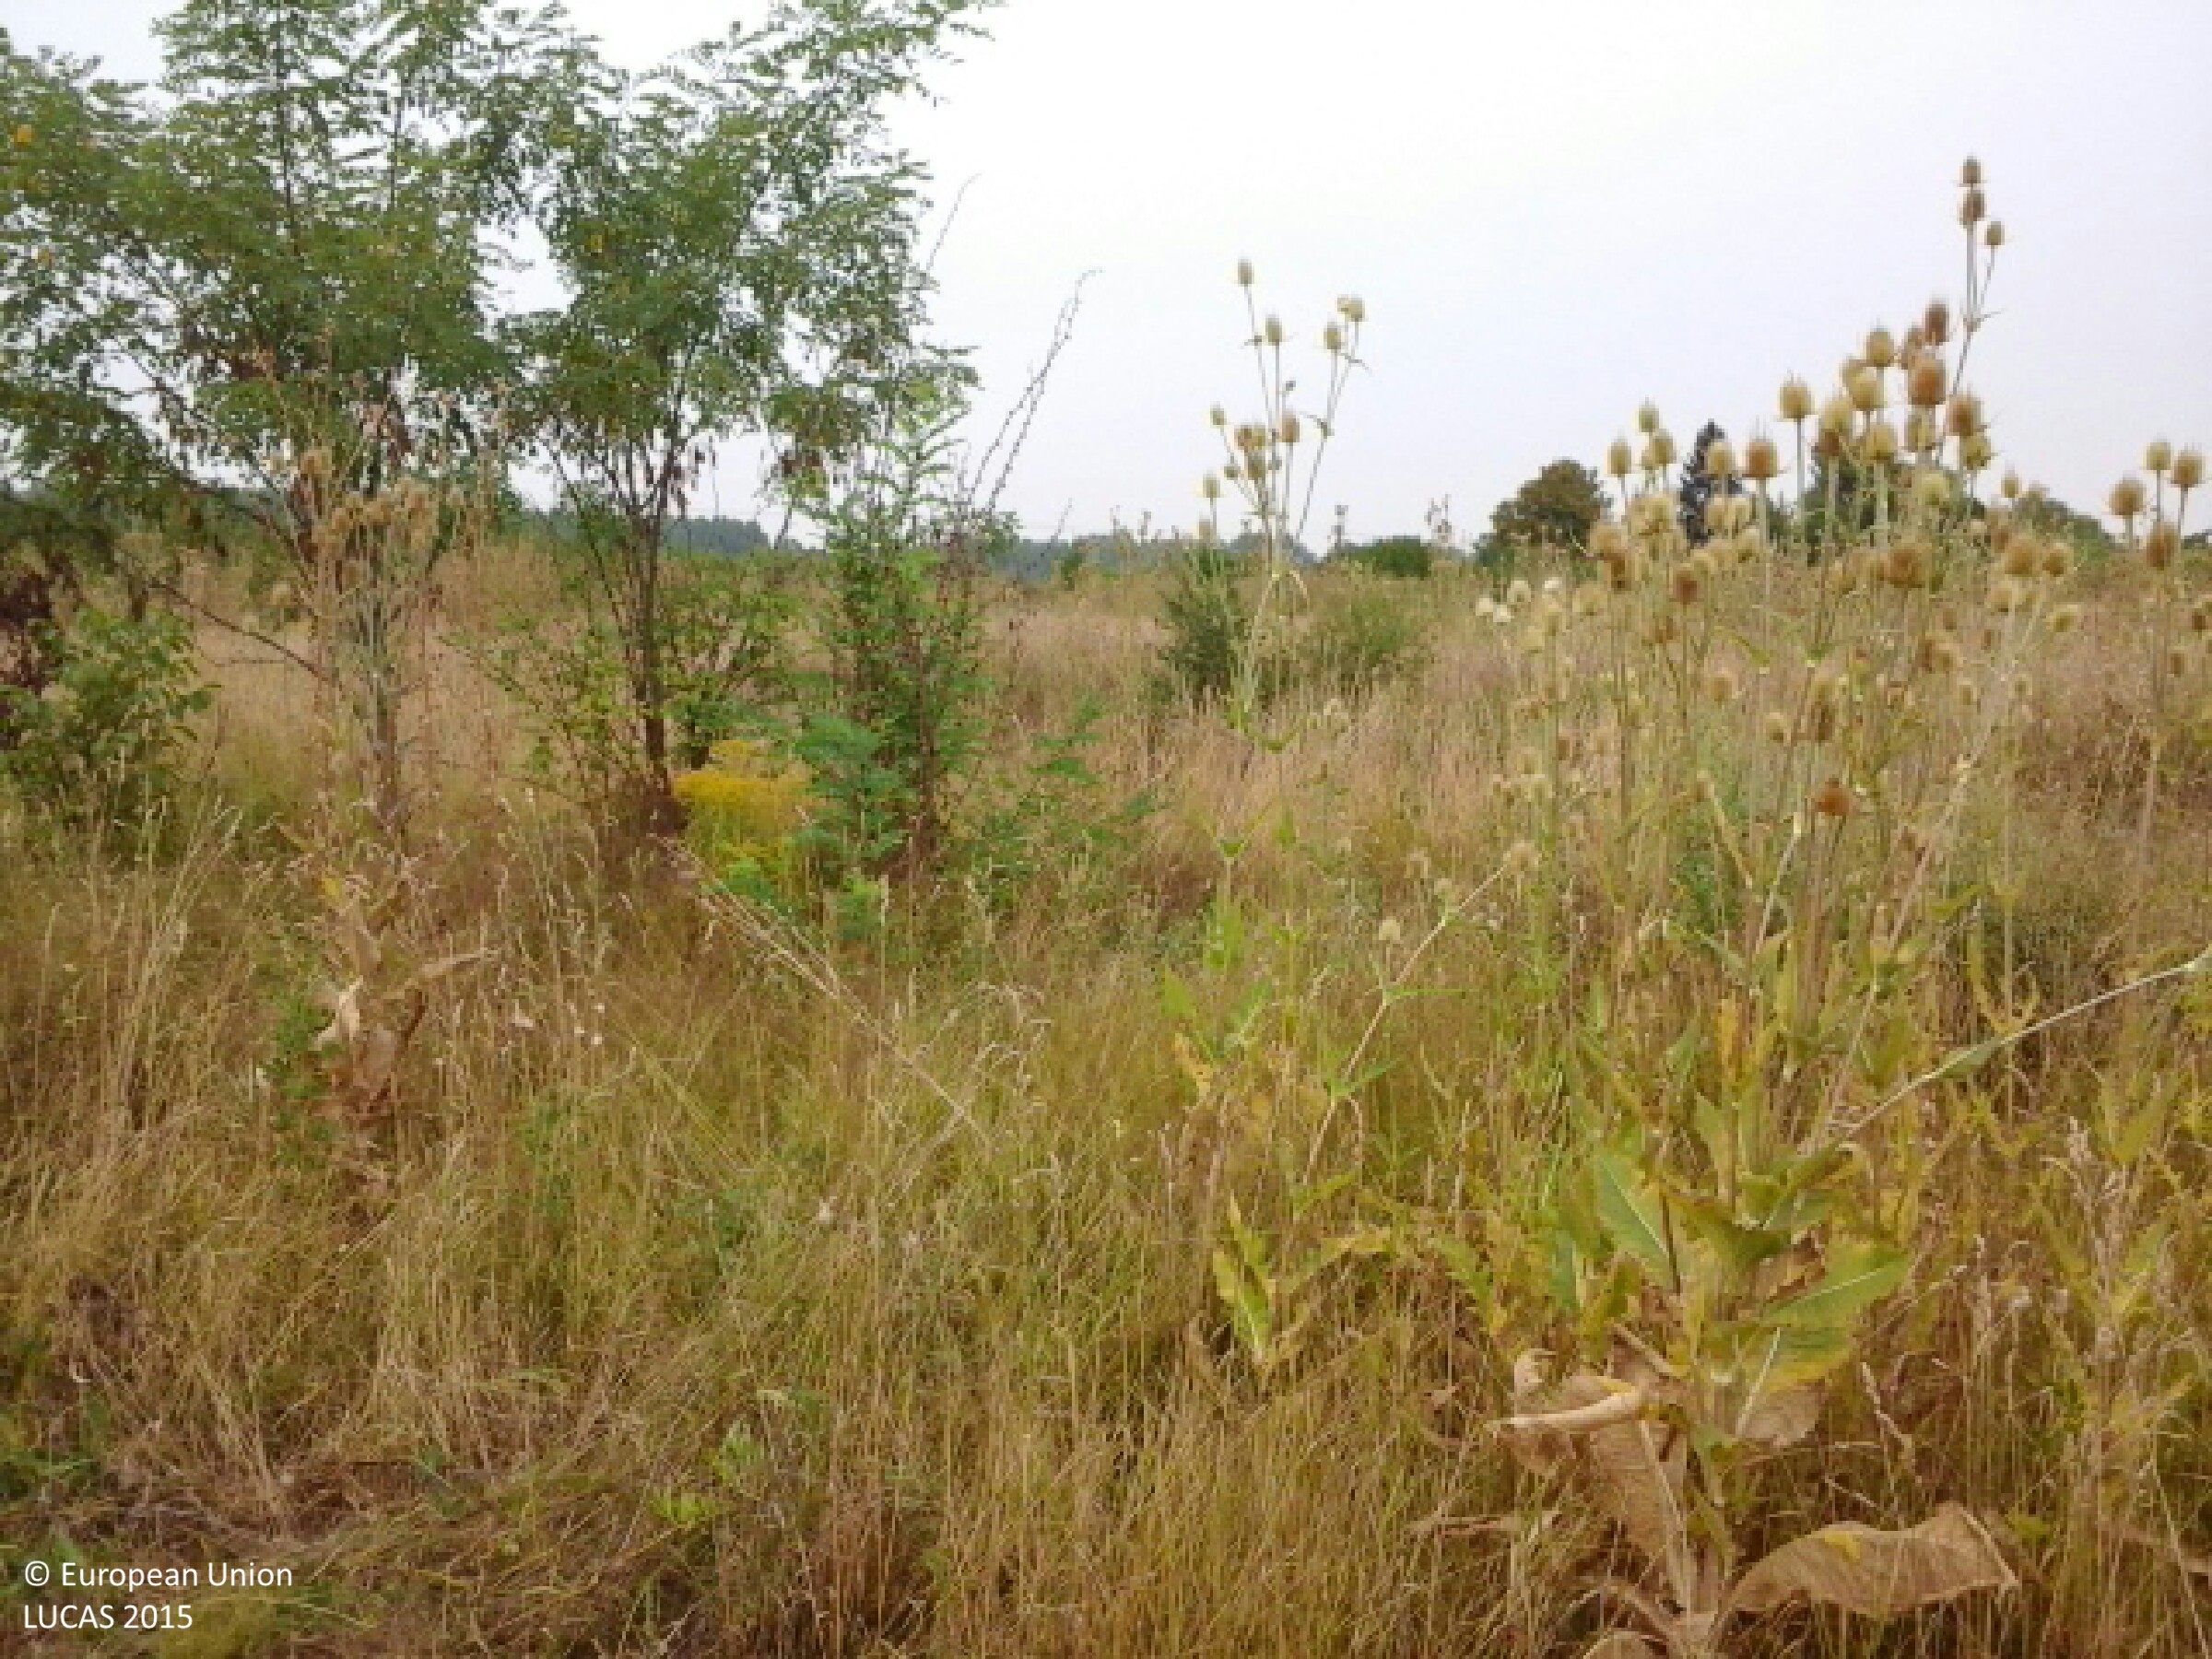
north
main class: Grassland
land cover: Spontaneously vegetated surfaces
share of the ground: > 75 %
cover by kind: herbaceous plants 100 %
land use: Semi-natural and natural areas not in use
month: August
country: HU
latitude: 47.1513
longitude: 21.7958
